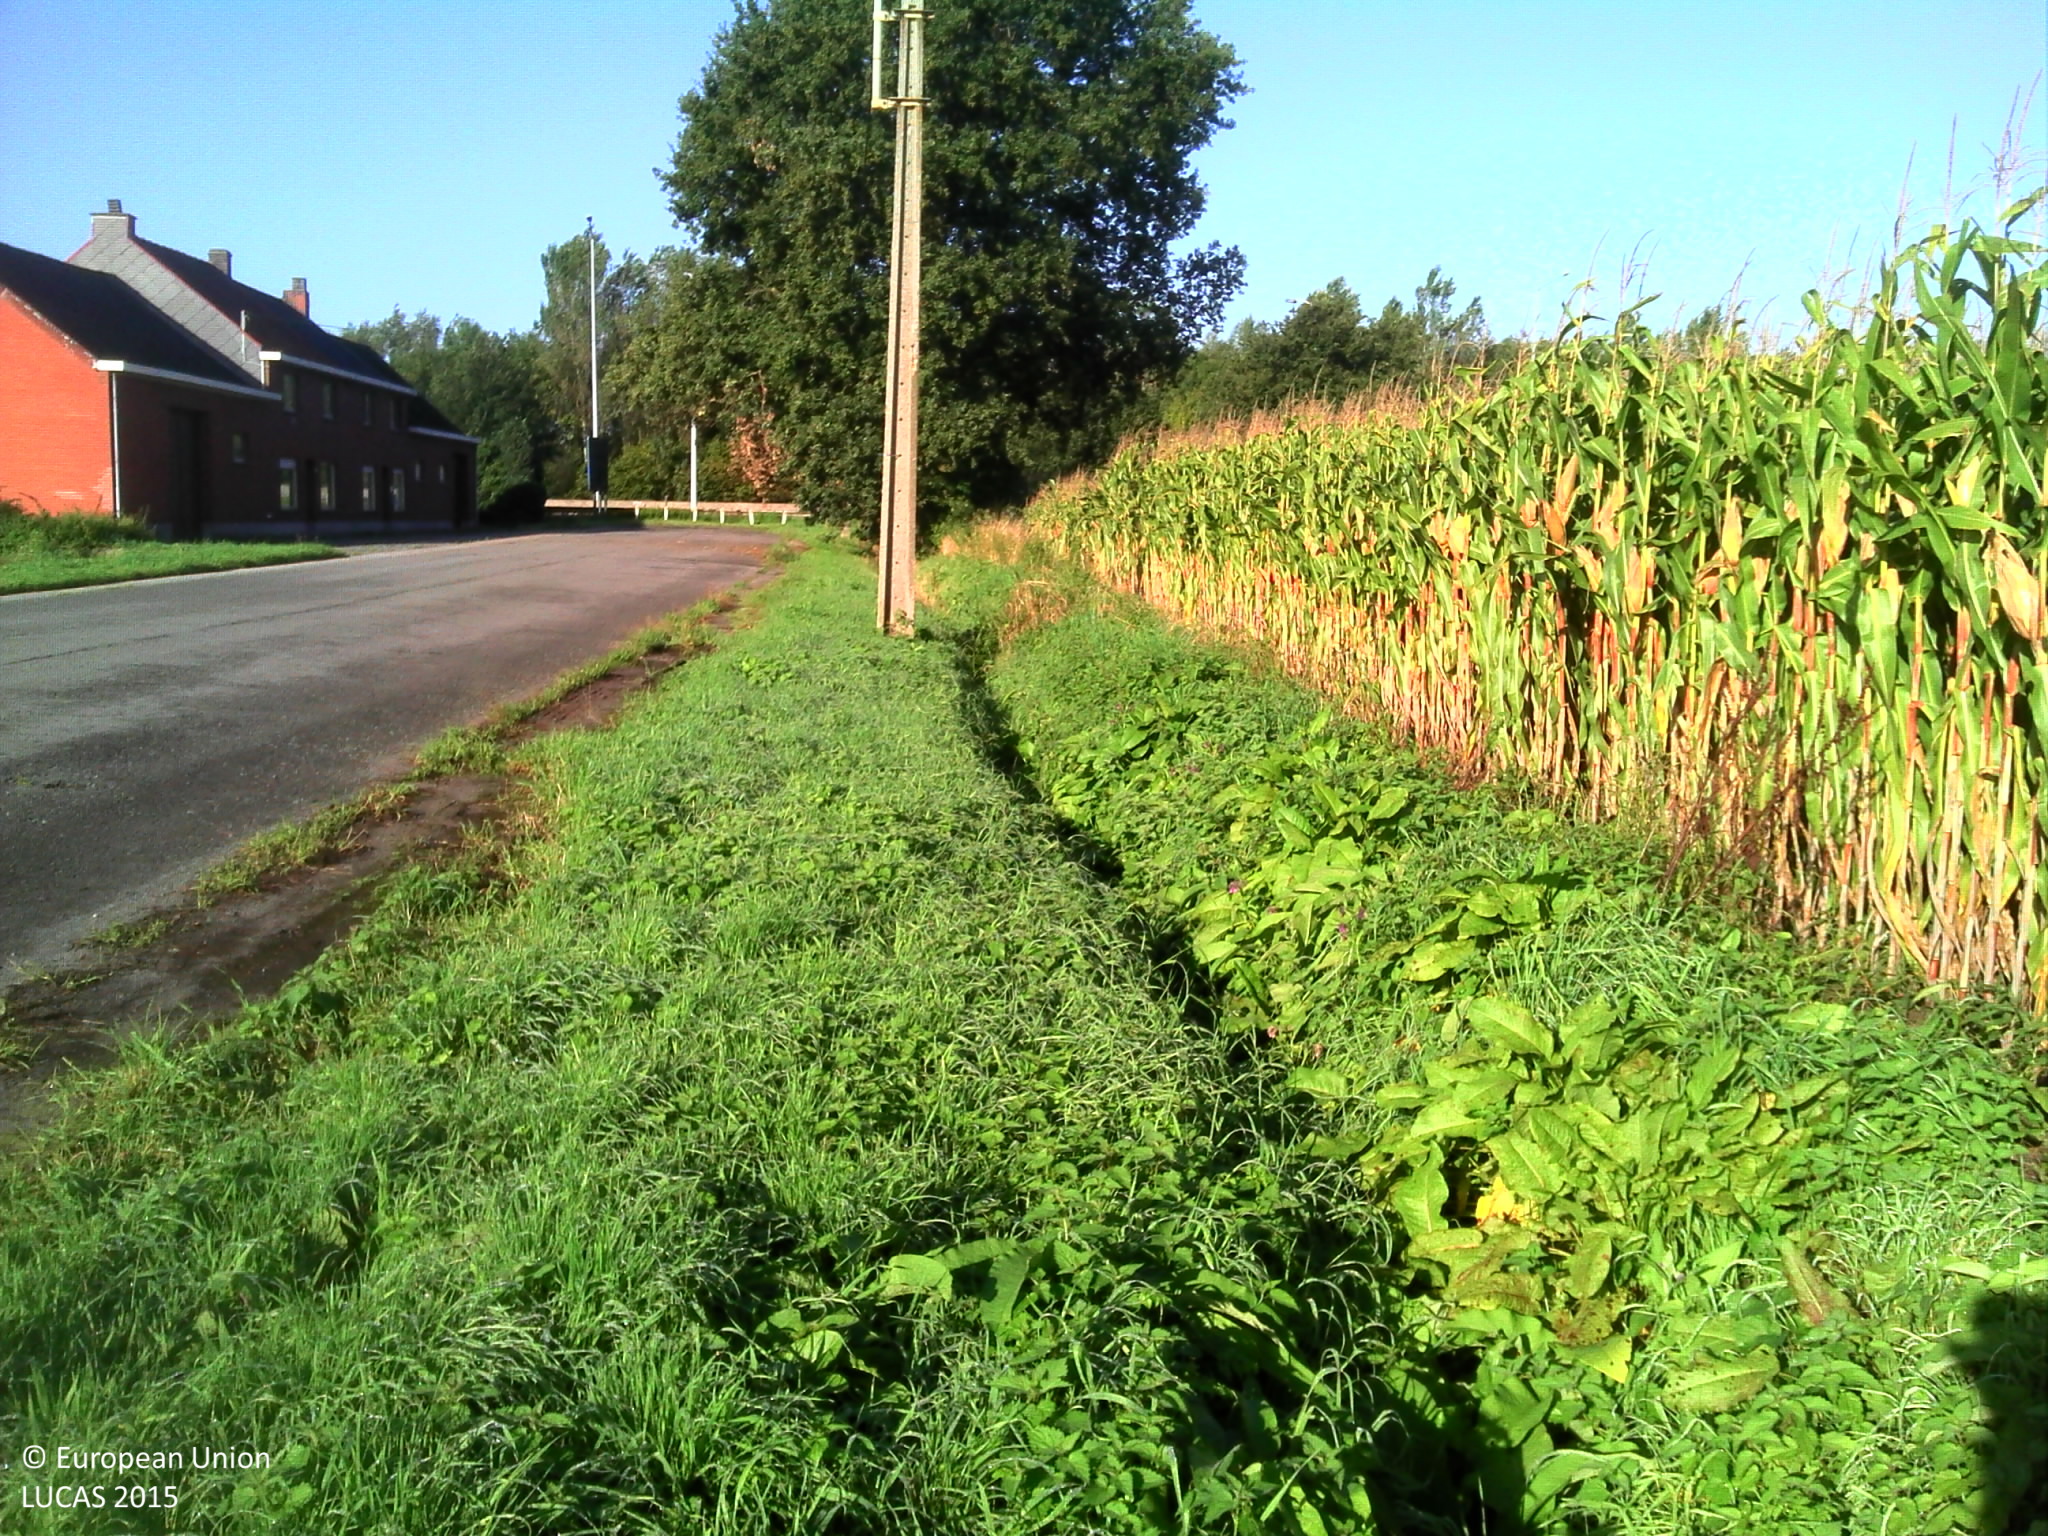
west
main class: Cropland
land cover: Maize
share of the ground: > 75 %
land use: Agriculture (excluding fallow land and kitchen gardens)
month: September
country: BE
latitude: 51.0940
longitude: 4.4412
